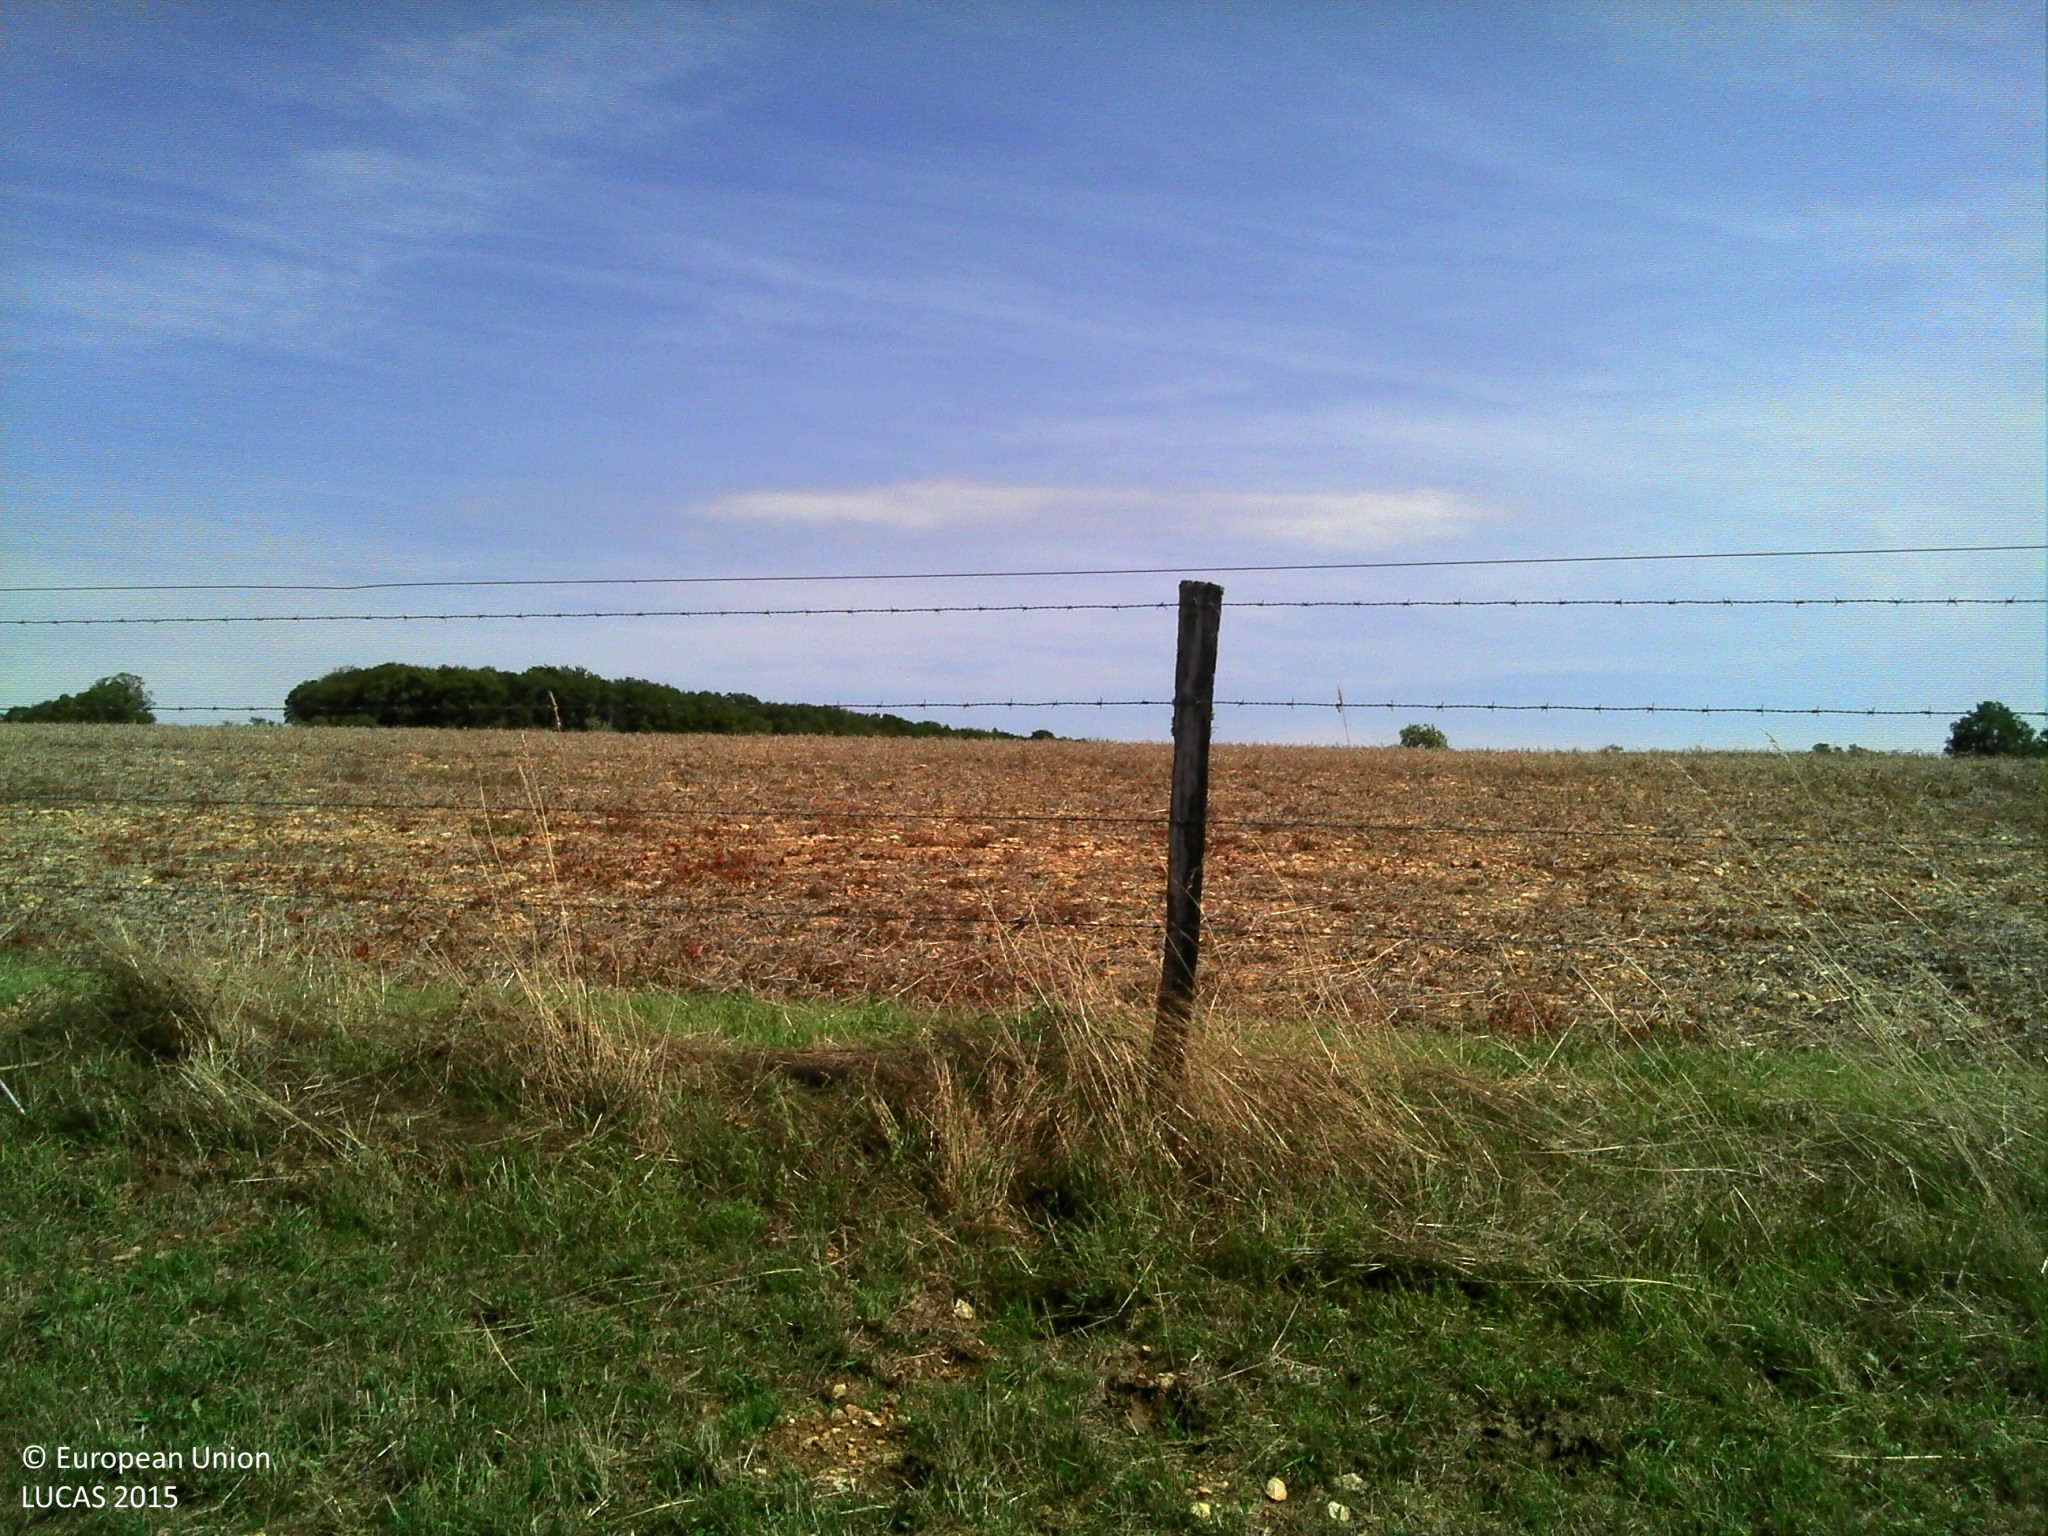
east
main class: Grassland
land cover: Grassland without tree/shrub cover
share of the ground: > 75 %
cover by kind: herbaceous plants 100 %
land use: Agriculture (excluding fallow land and kitchen gardens)
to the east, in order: Grassland without tree/shrub cover; Fences; Grass margins; Dry pulses; Grass margins; Tracks; Barley
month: August
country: FR
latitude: 47.7470
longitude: 4.9445
